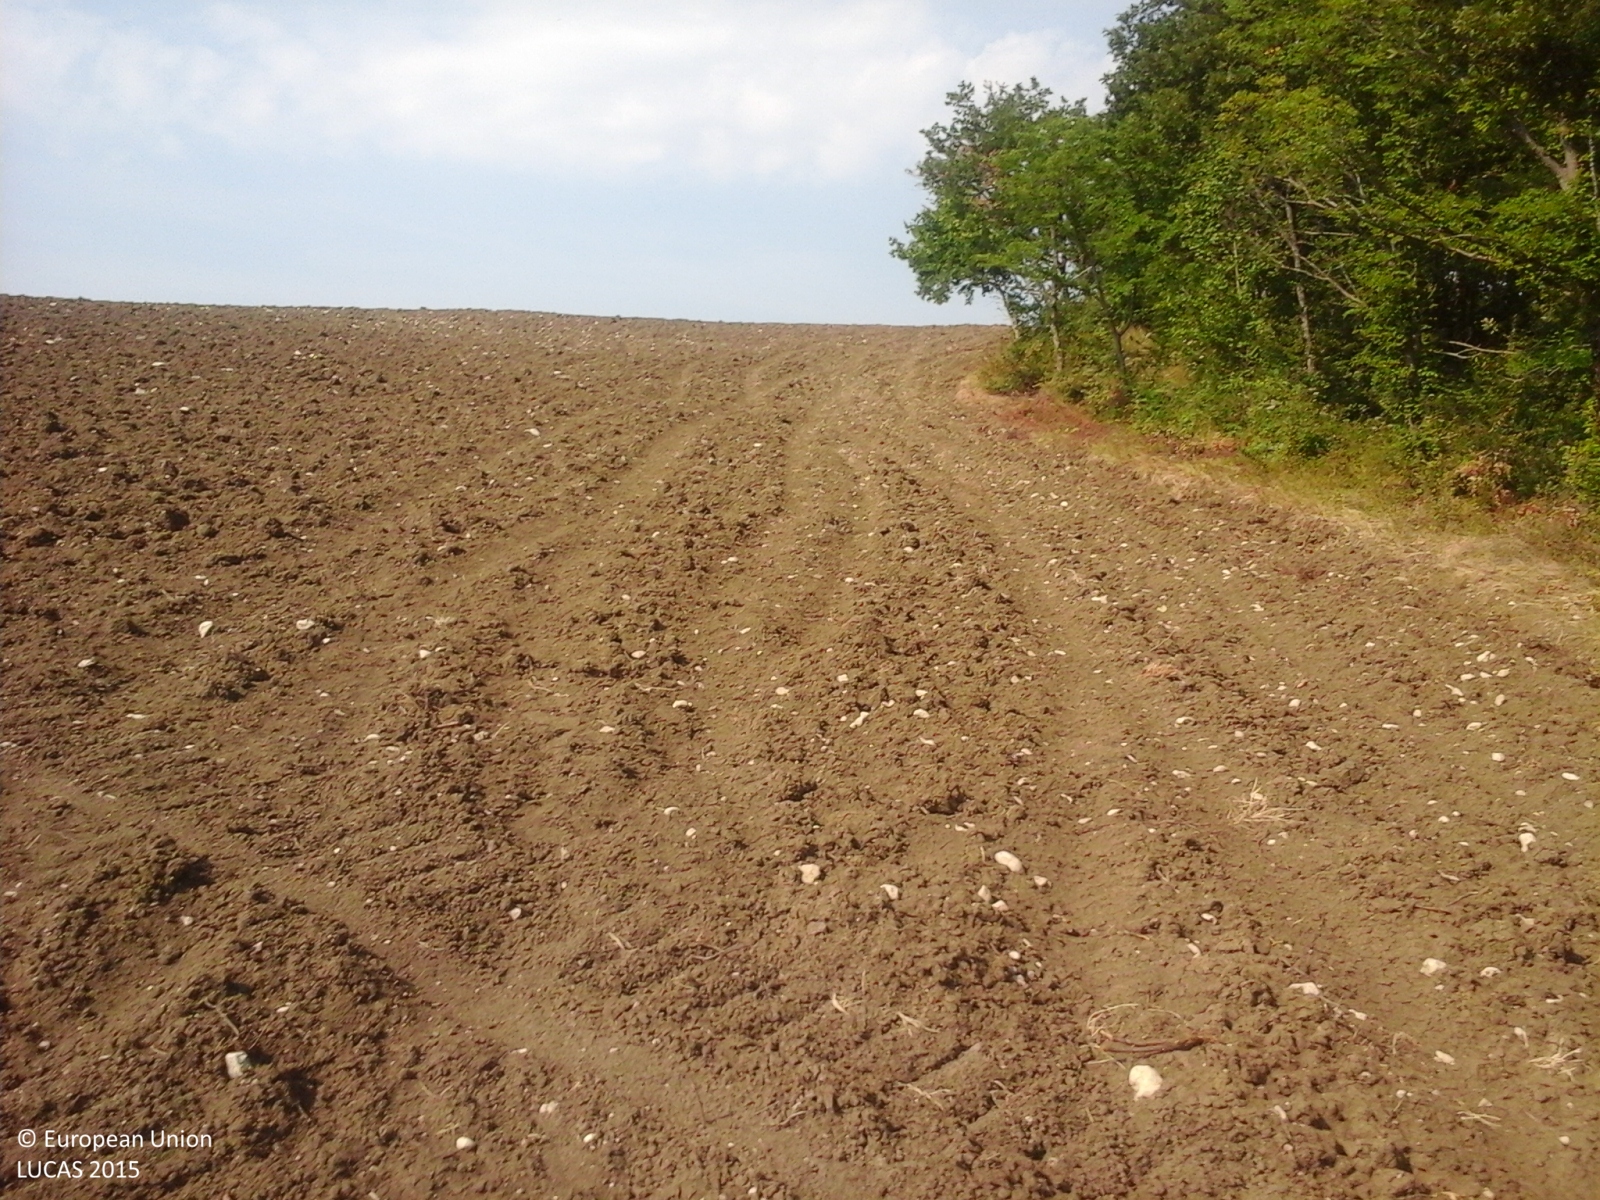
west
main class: Cropland
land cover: Oats
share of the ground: > 75 %
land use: Agriculture (excluding fallow land and kitchen gardens)
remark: Harvested field
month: August
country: IT
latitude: 43.8357
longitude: 12.3944
